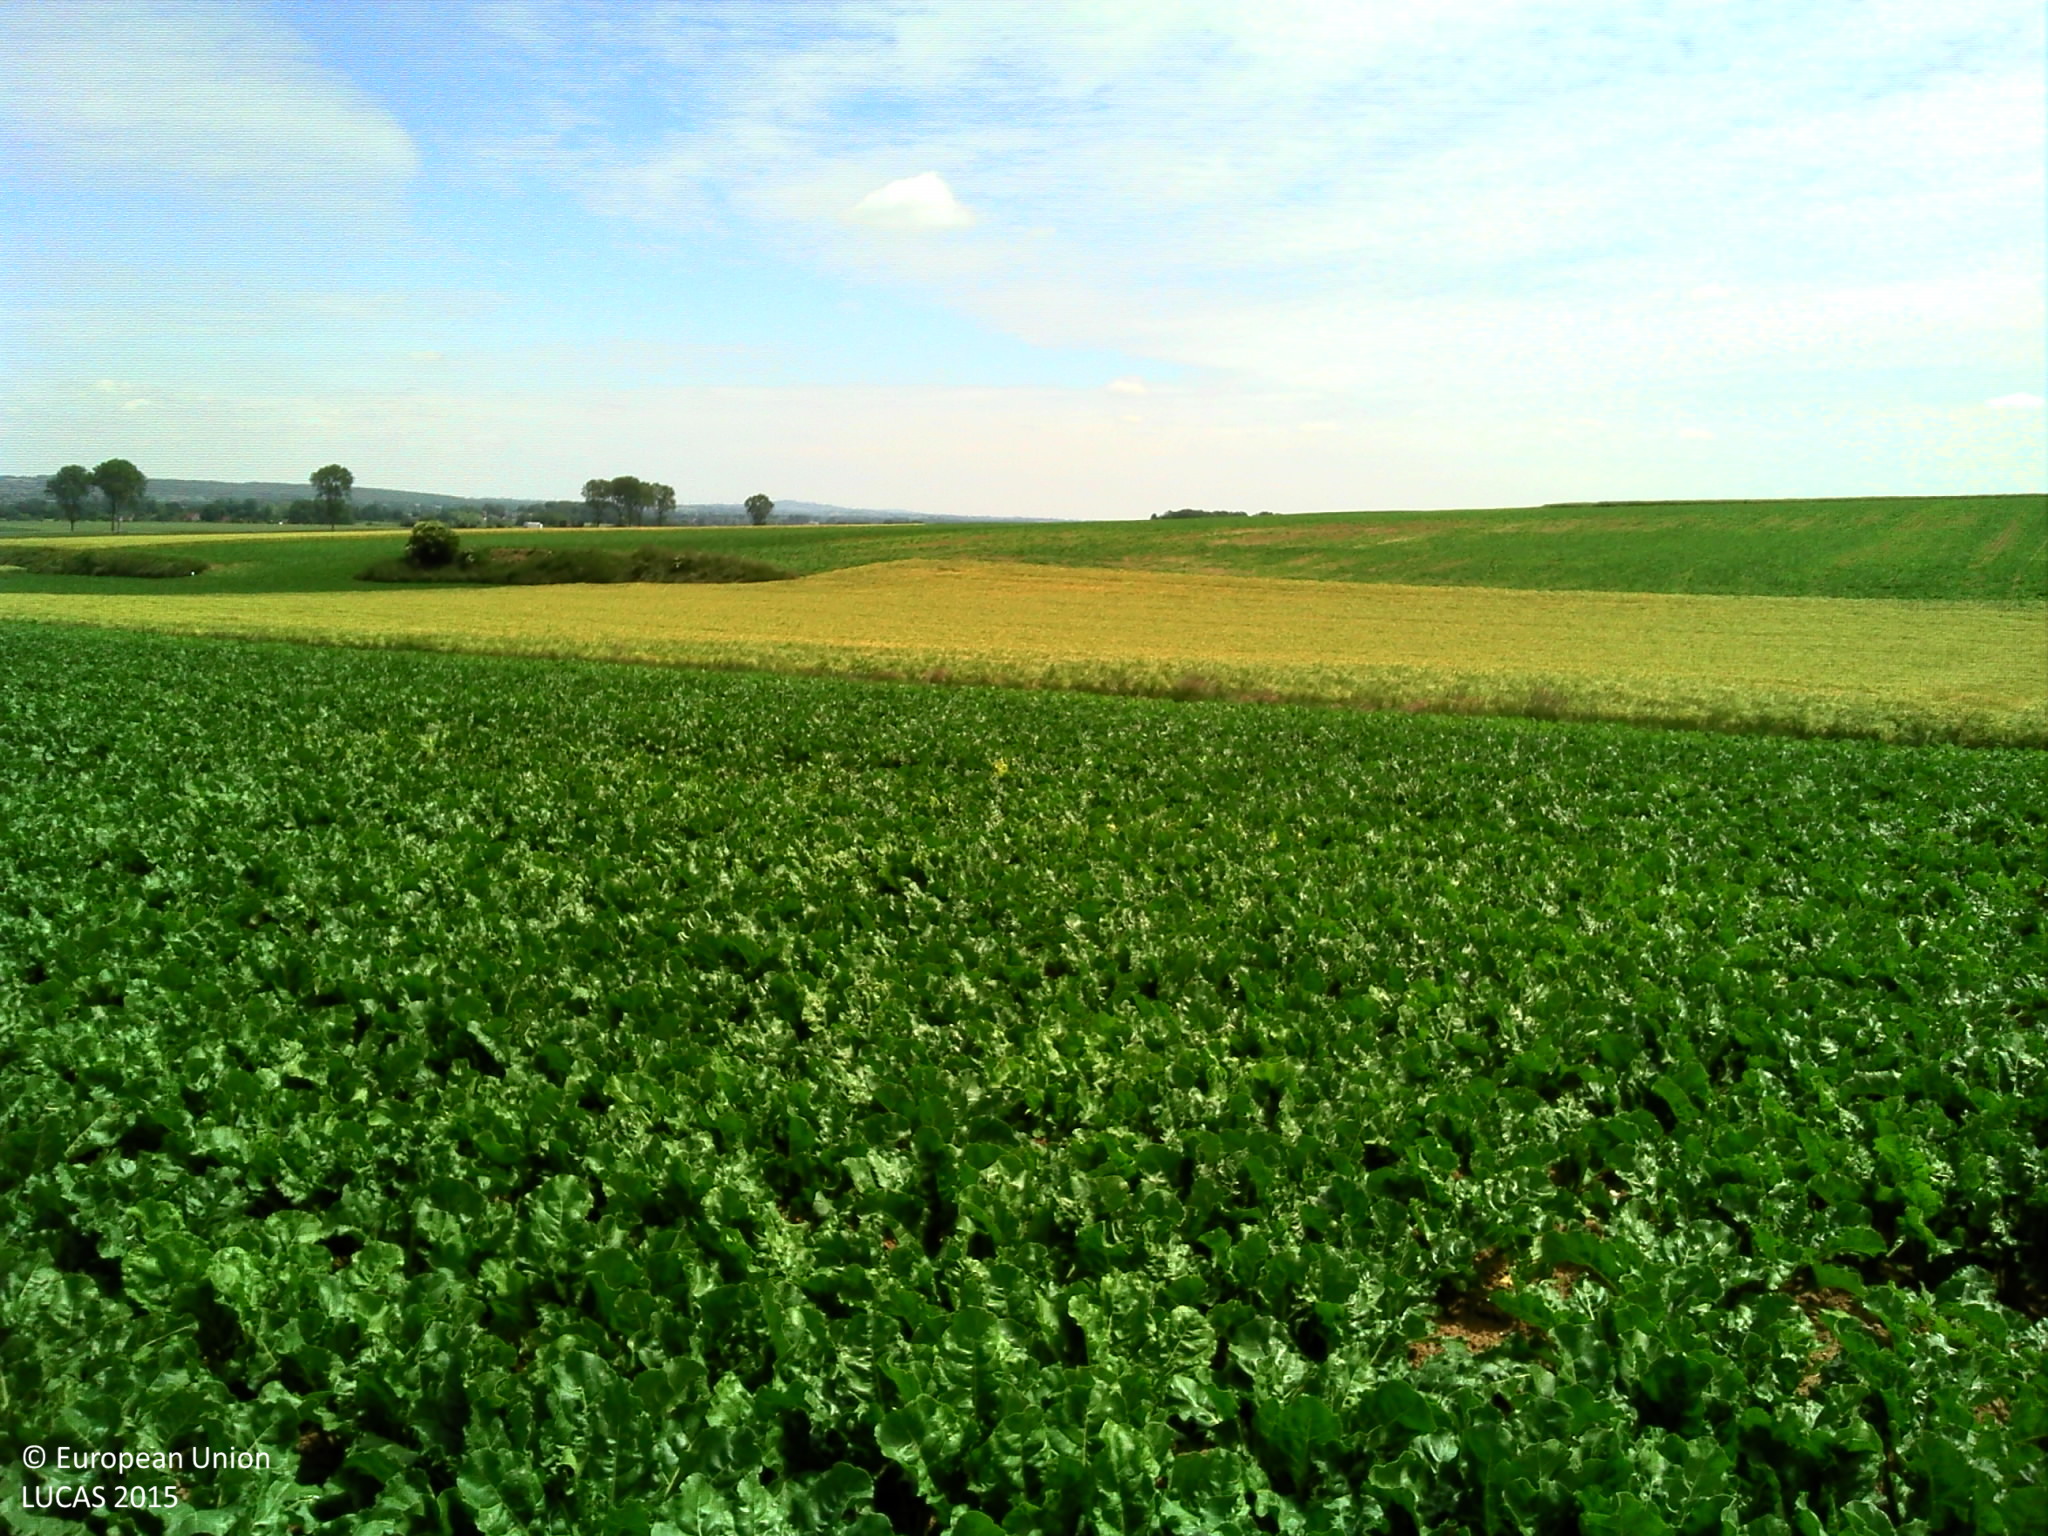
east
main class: Cropland
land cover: Sugar beet
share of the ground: > 75 %
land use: Agriculture (excluding fallow land and kitchen gardens)
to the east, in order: Sugar beet; Grass margins; Paved roads, cycling and walking lanes; Grass margins; Barley; Sugar beet
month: June
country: FR
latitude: 50.7960
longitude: 2.1109
